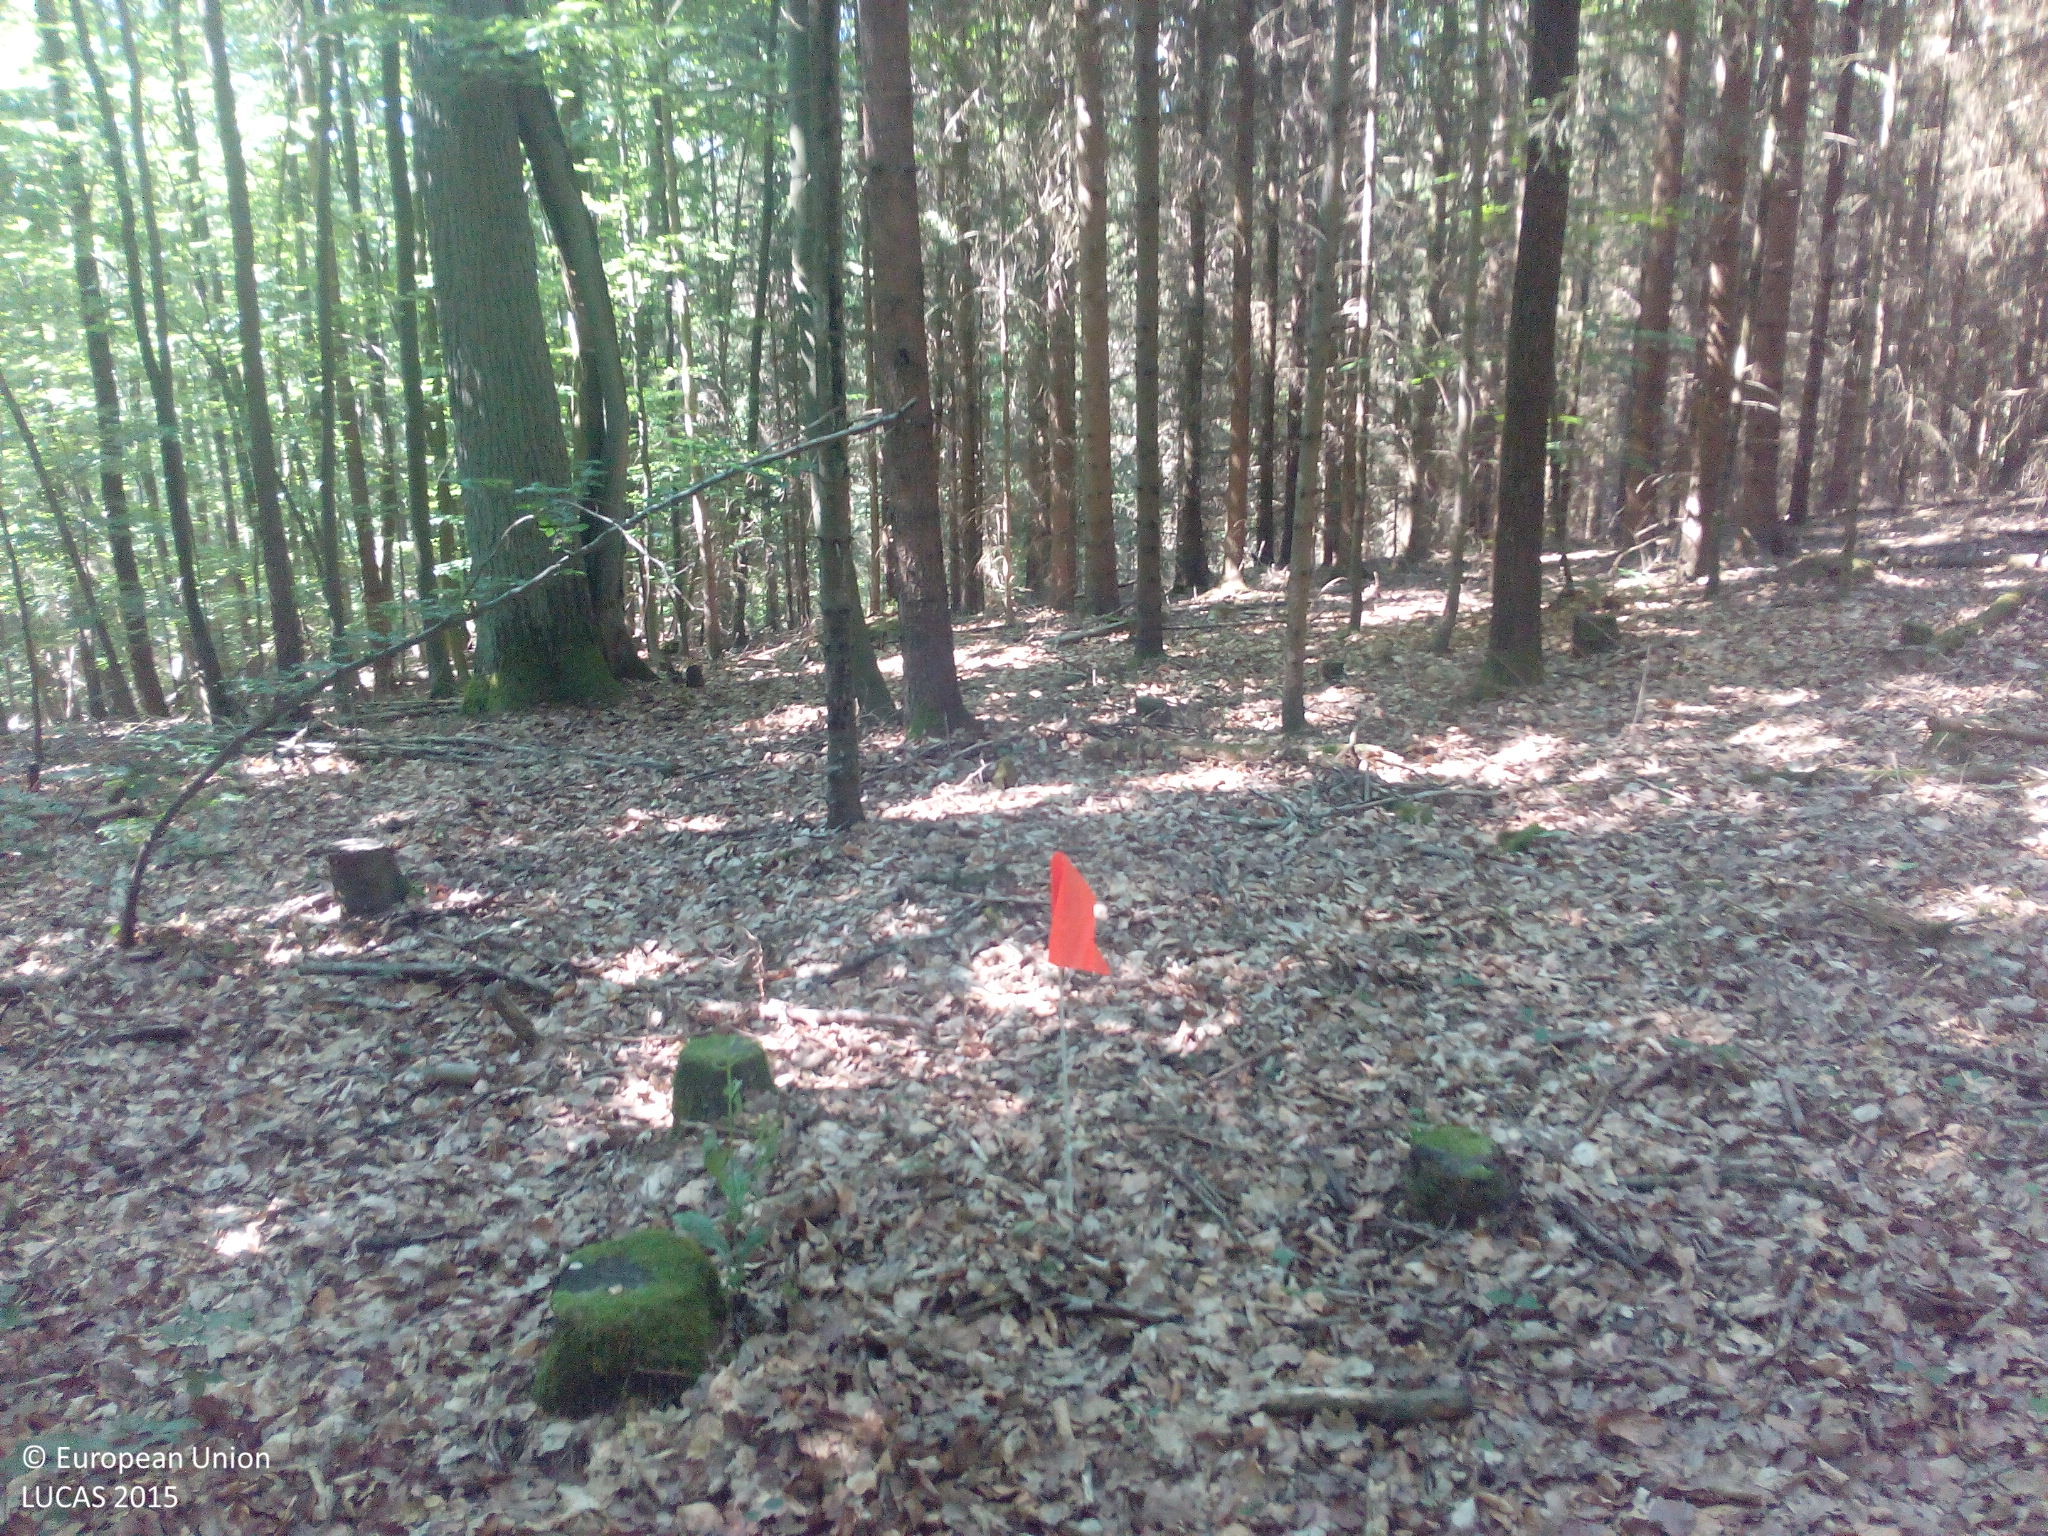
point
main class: Woodland
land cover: Spruce dominated mixed woodland
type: hemiboreal forest and nemoral coniferous forest and mixed broadleaved-coniferous forest
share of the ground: > 75 %
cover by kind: coniferous forest trees 70 %, broadleaved forest trees 25 %, unconsolidated bare surface 5 %
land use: Forestry
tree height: > 5 m
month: July
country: DE
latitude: 50.2529
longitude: 10.8553
